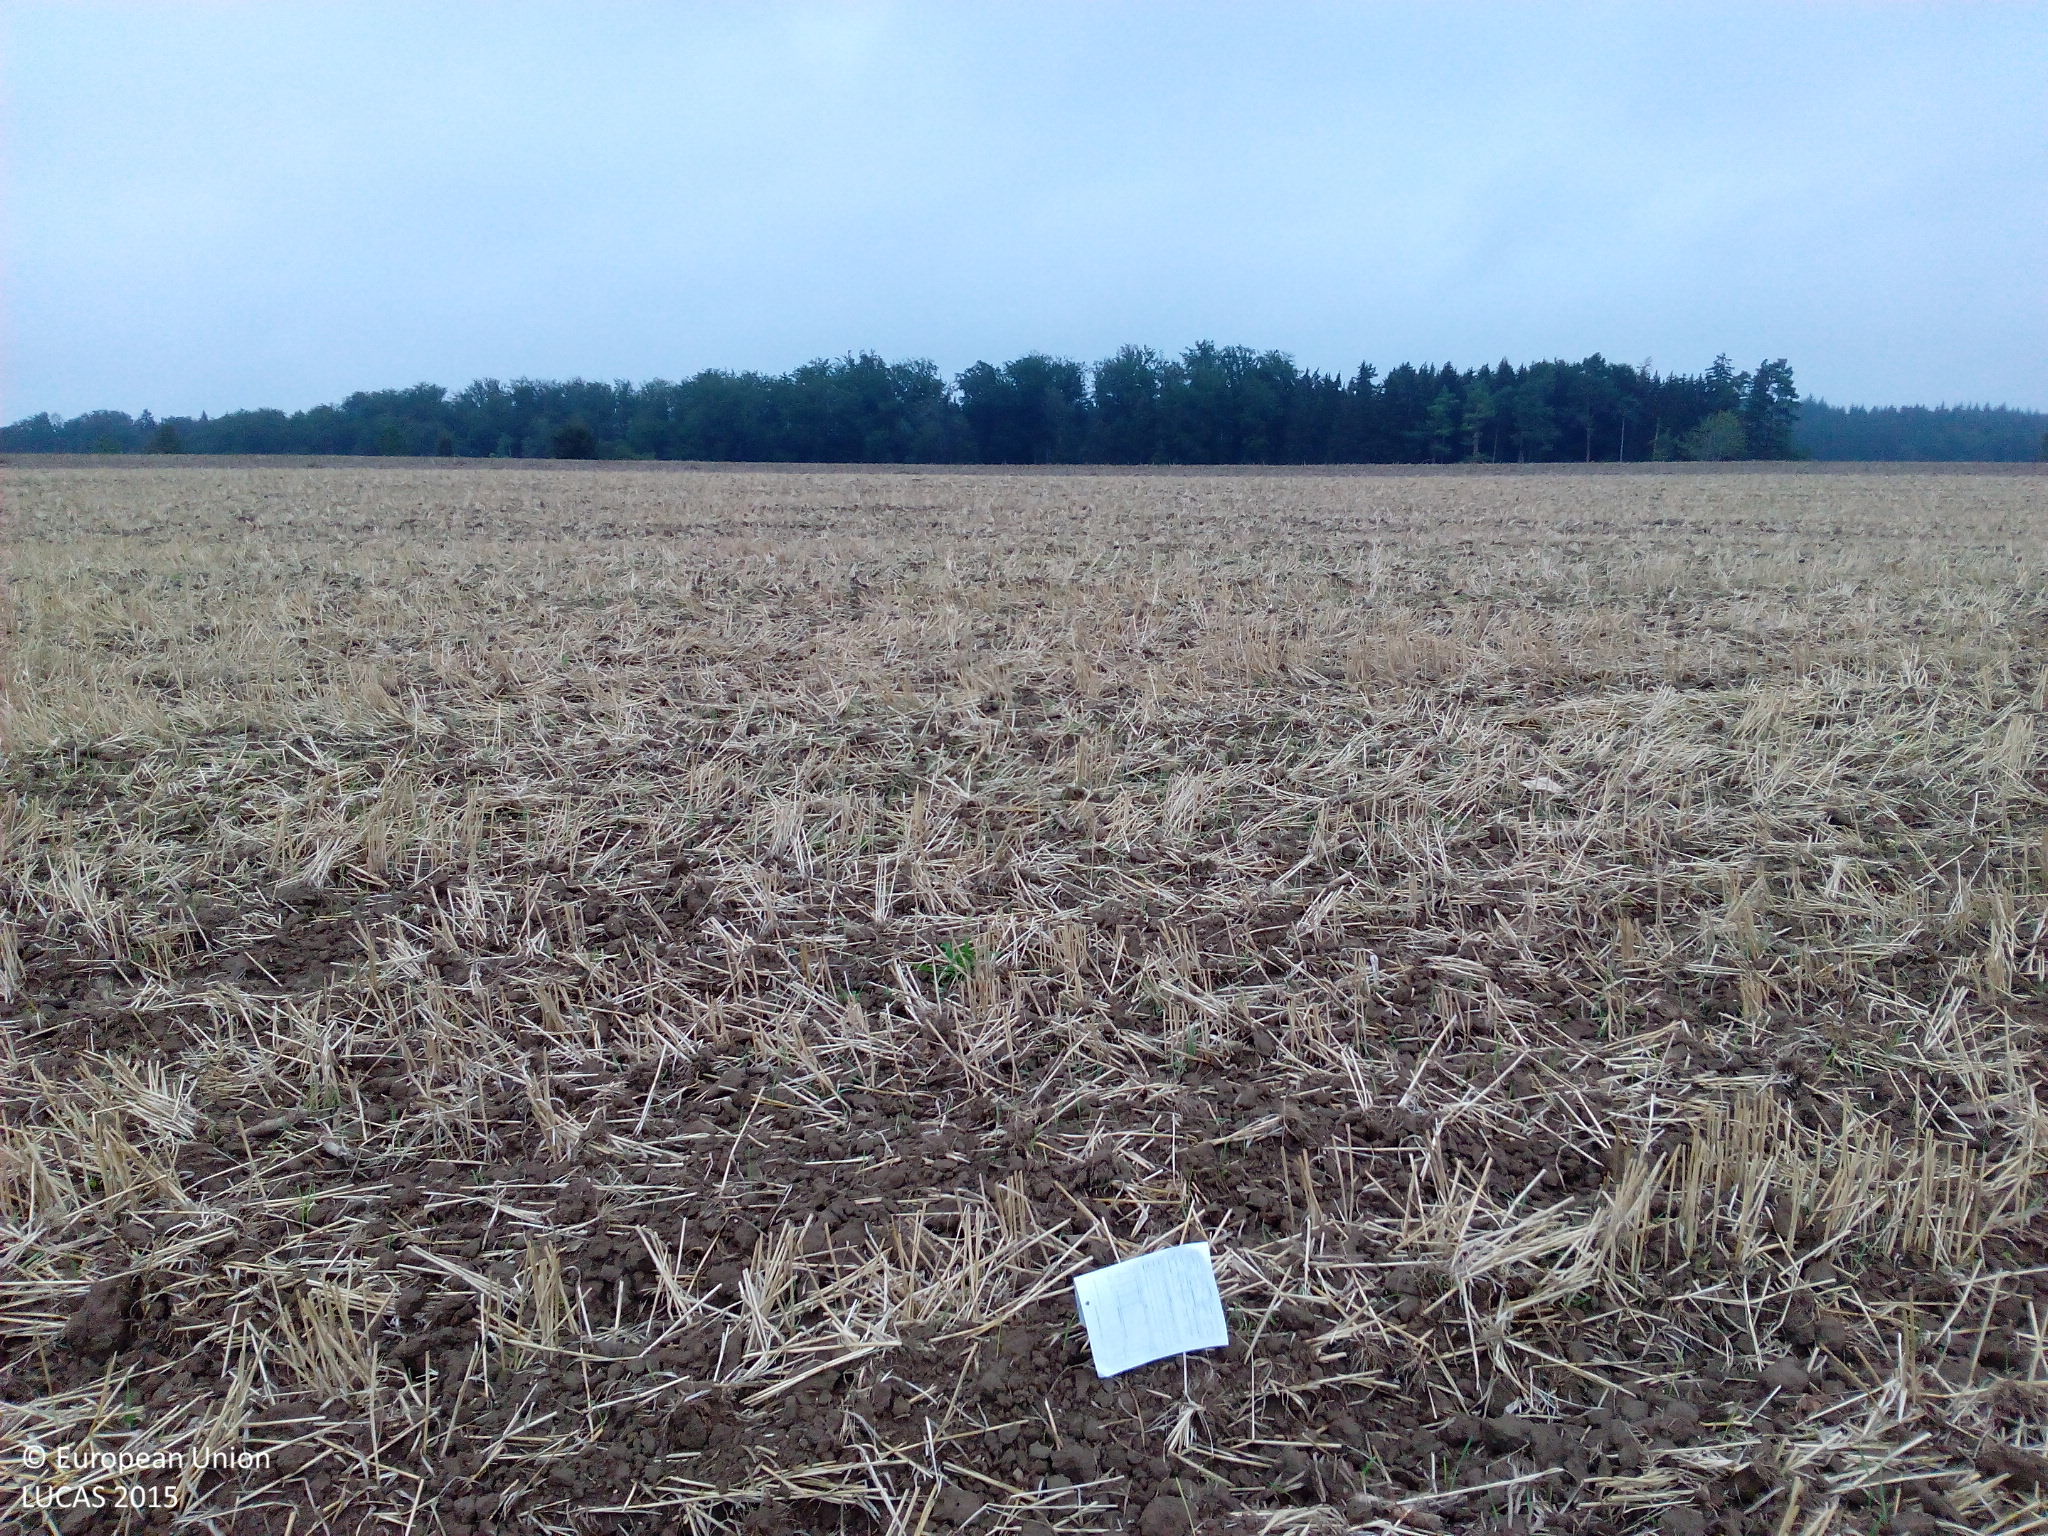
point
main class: Cropland
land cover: Common wheat
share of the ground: 25 - 50 %
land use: Agriculture (excluding fallow land and kitchen gardens)
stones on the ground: < 10 %
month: August
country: DE
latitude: 48.4934
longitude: 9.9594
